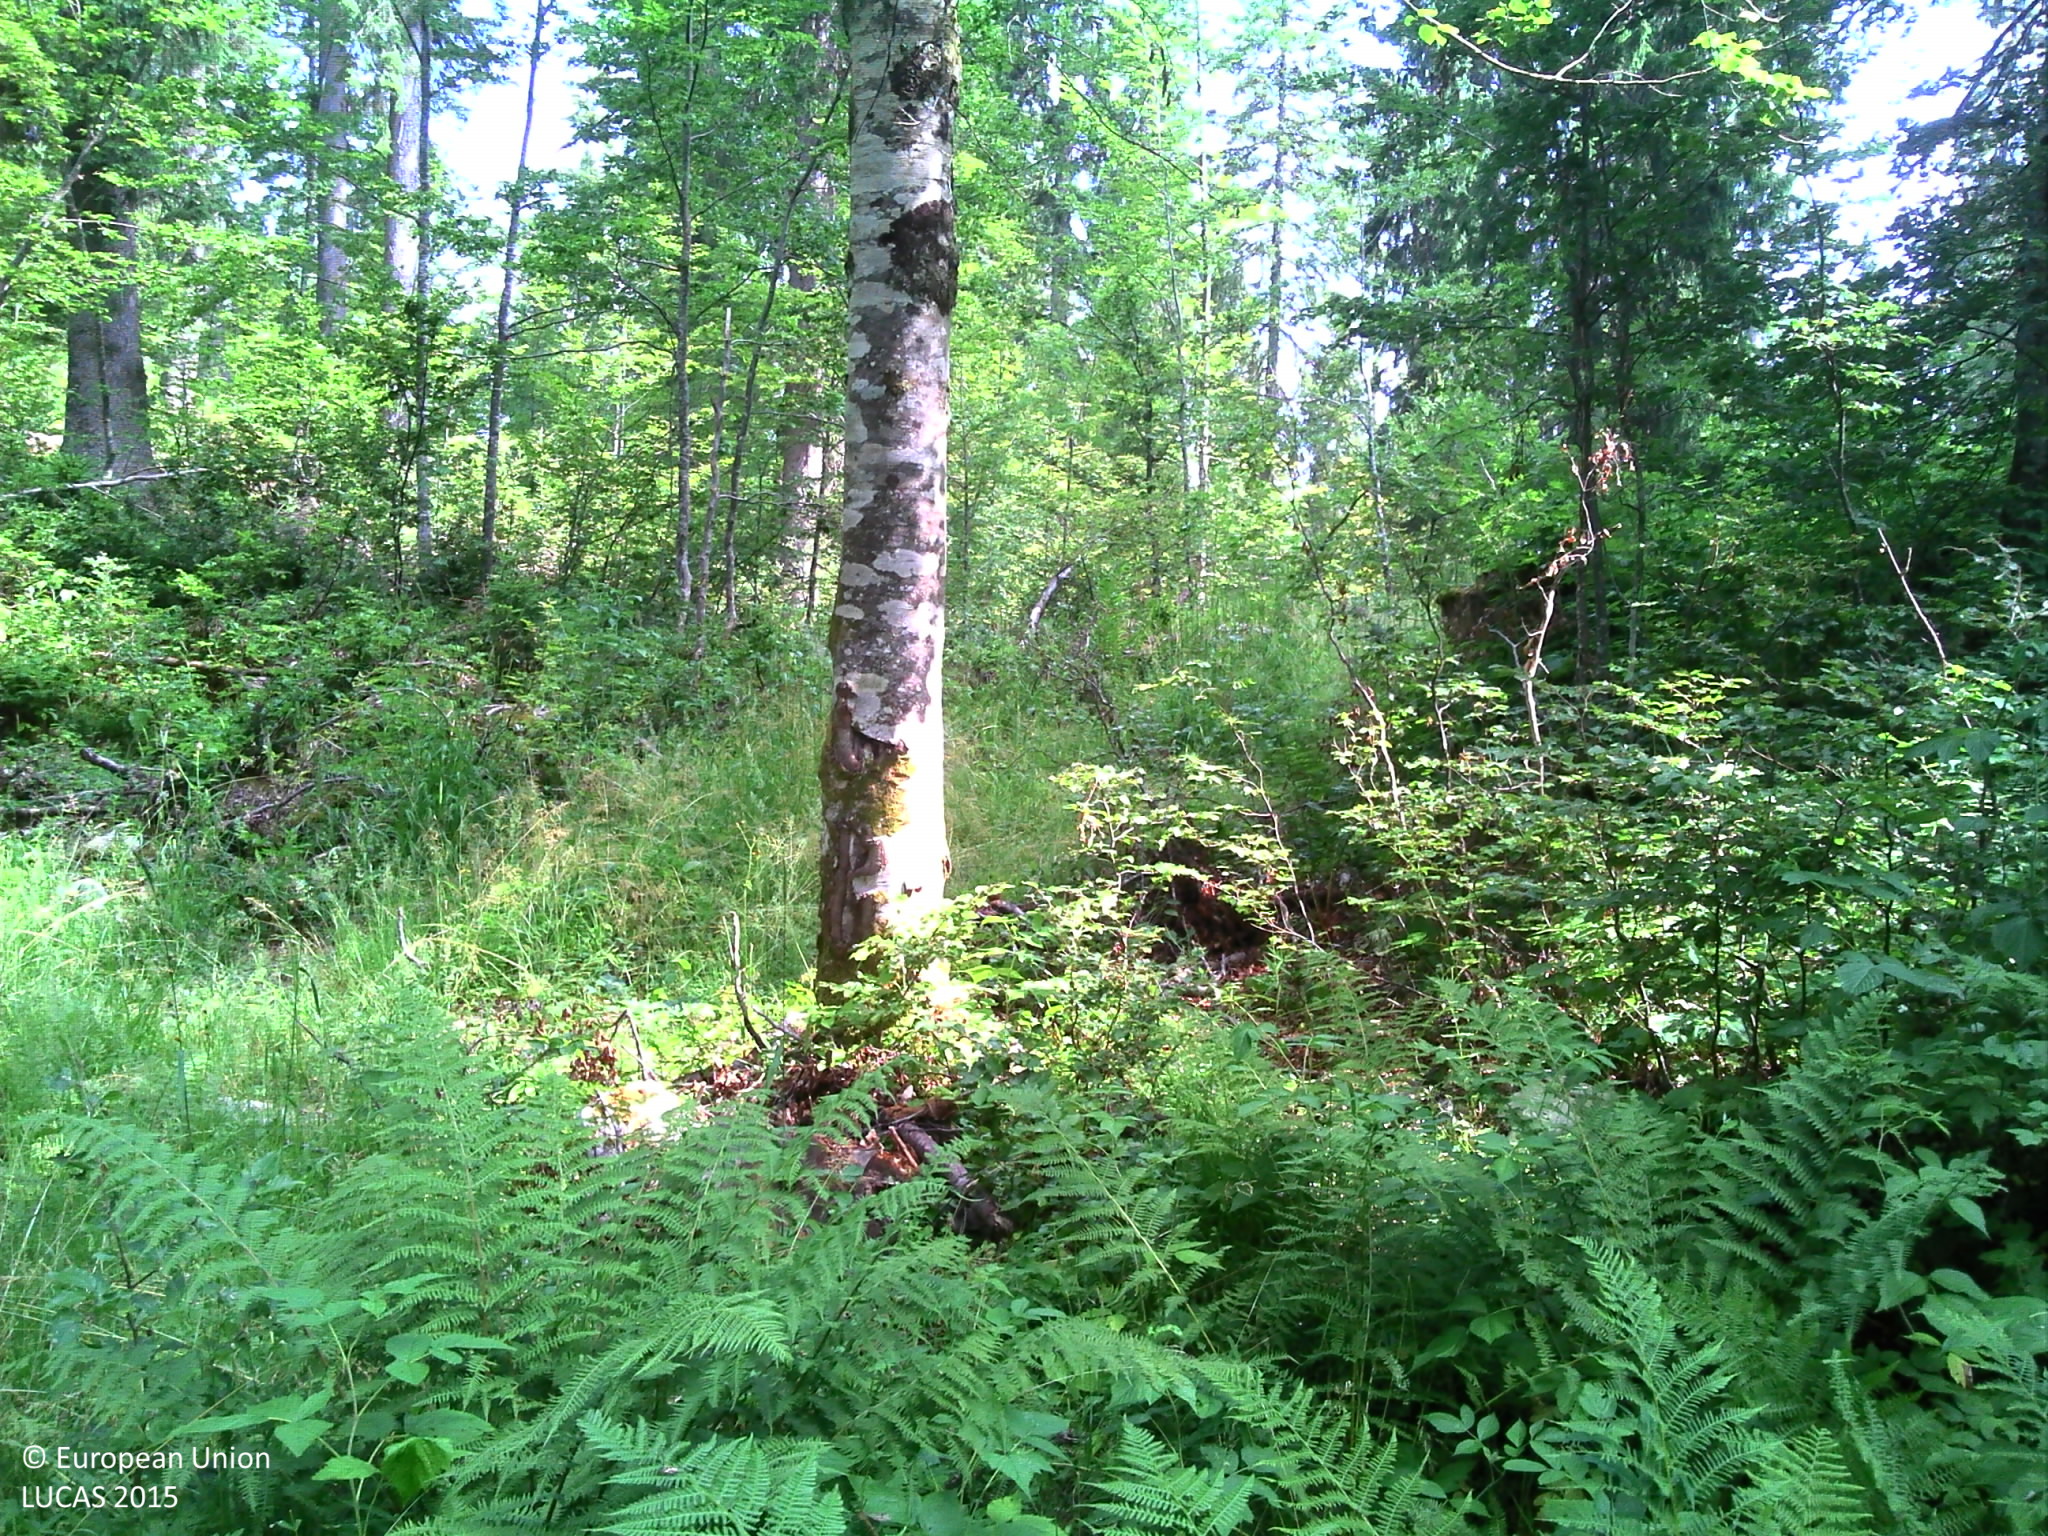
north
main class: Woodland
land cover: Spruce dominated mixed woodland
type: mountainous beech forest
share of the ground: 50 - 75 %
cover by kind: herbaceous plants 35 %, consolidated bare surface 20 %, coniferous forest trees 15 %, broadleaved forest trees 15 %, lichens and mosses 10 %, shrubs 5 %
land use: Forestry
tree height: > 5 m
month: July
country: FR
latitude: 46.5138
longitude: 6.0798
